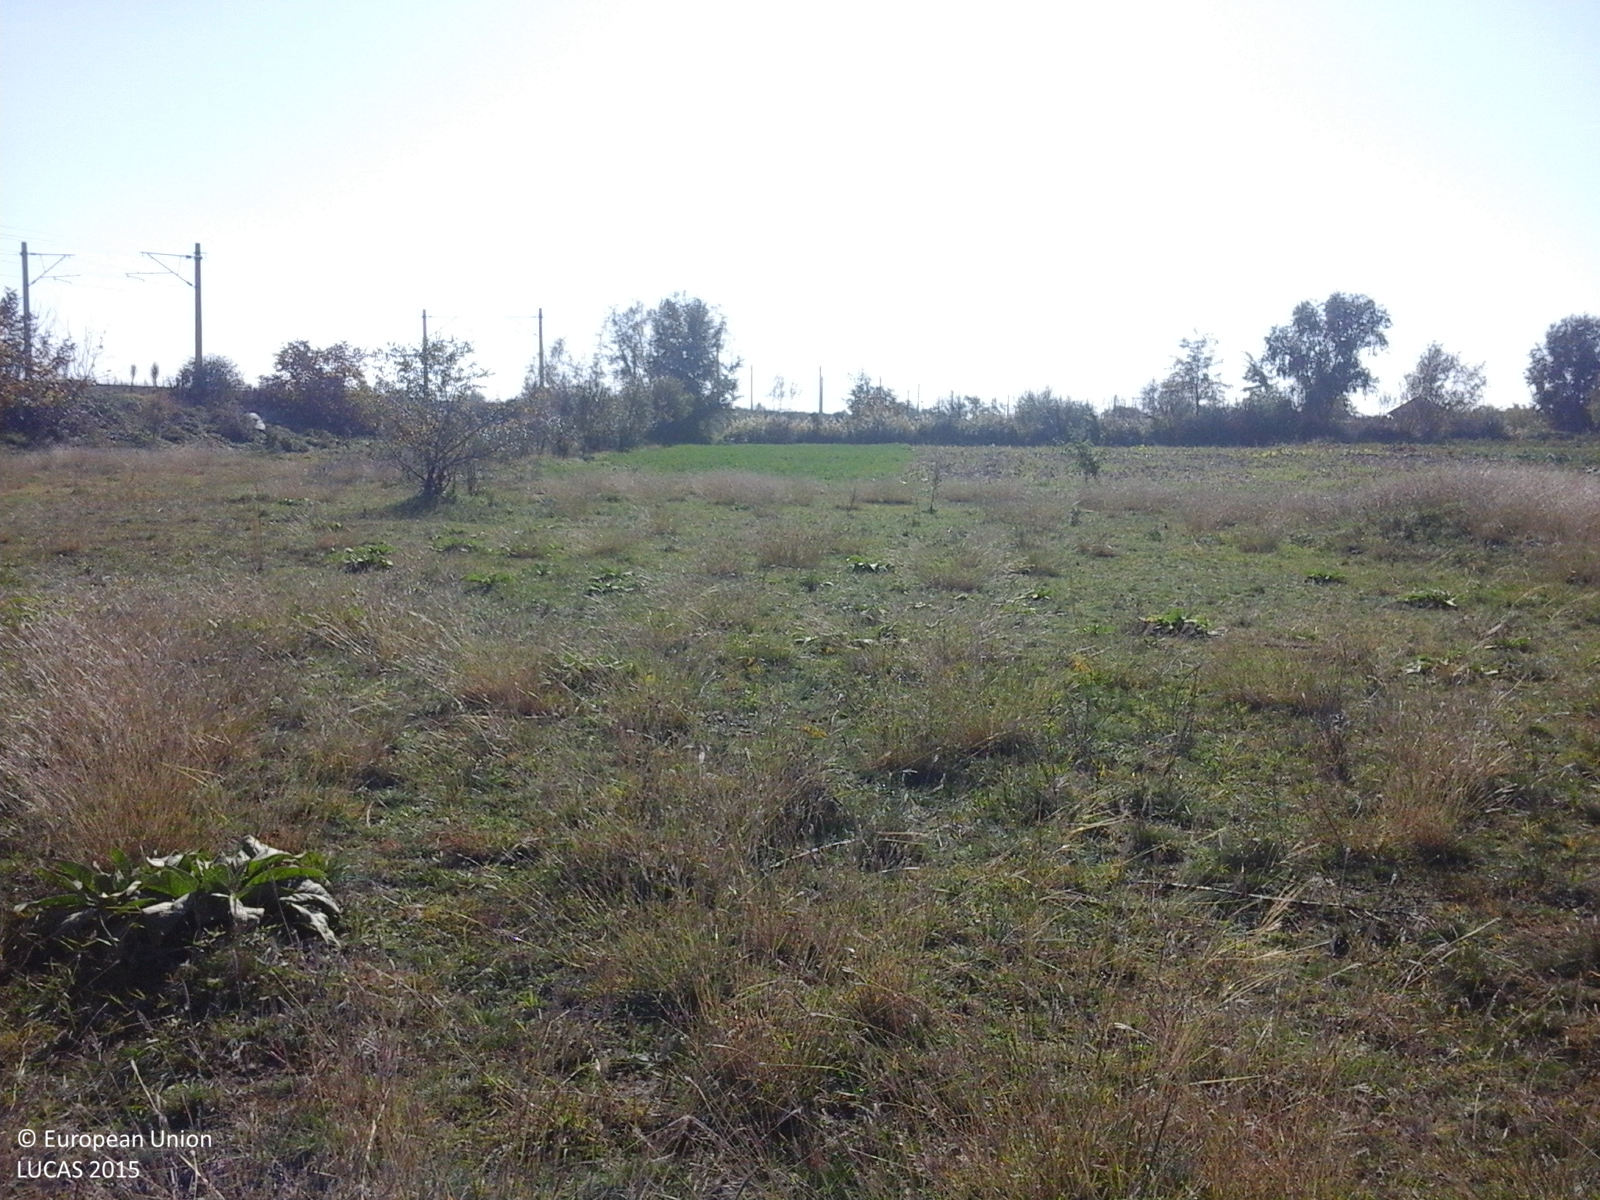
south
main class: Grassland
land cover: Grassland without tree/shrub cover
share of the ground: > 75 %
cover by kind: herbaceous plants 100 %
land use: Agriculture (excluding fallow land and kitchen gardens)
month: October
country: RO
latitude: 45.7920
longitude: 27.1925
